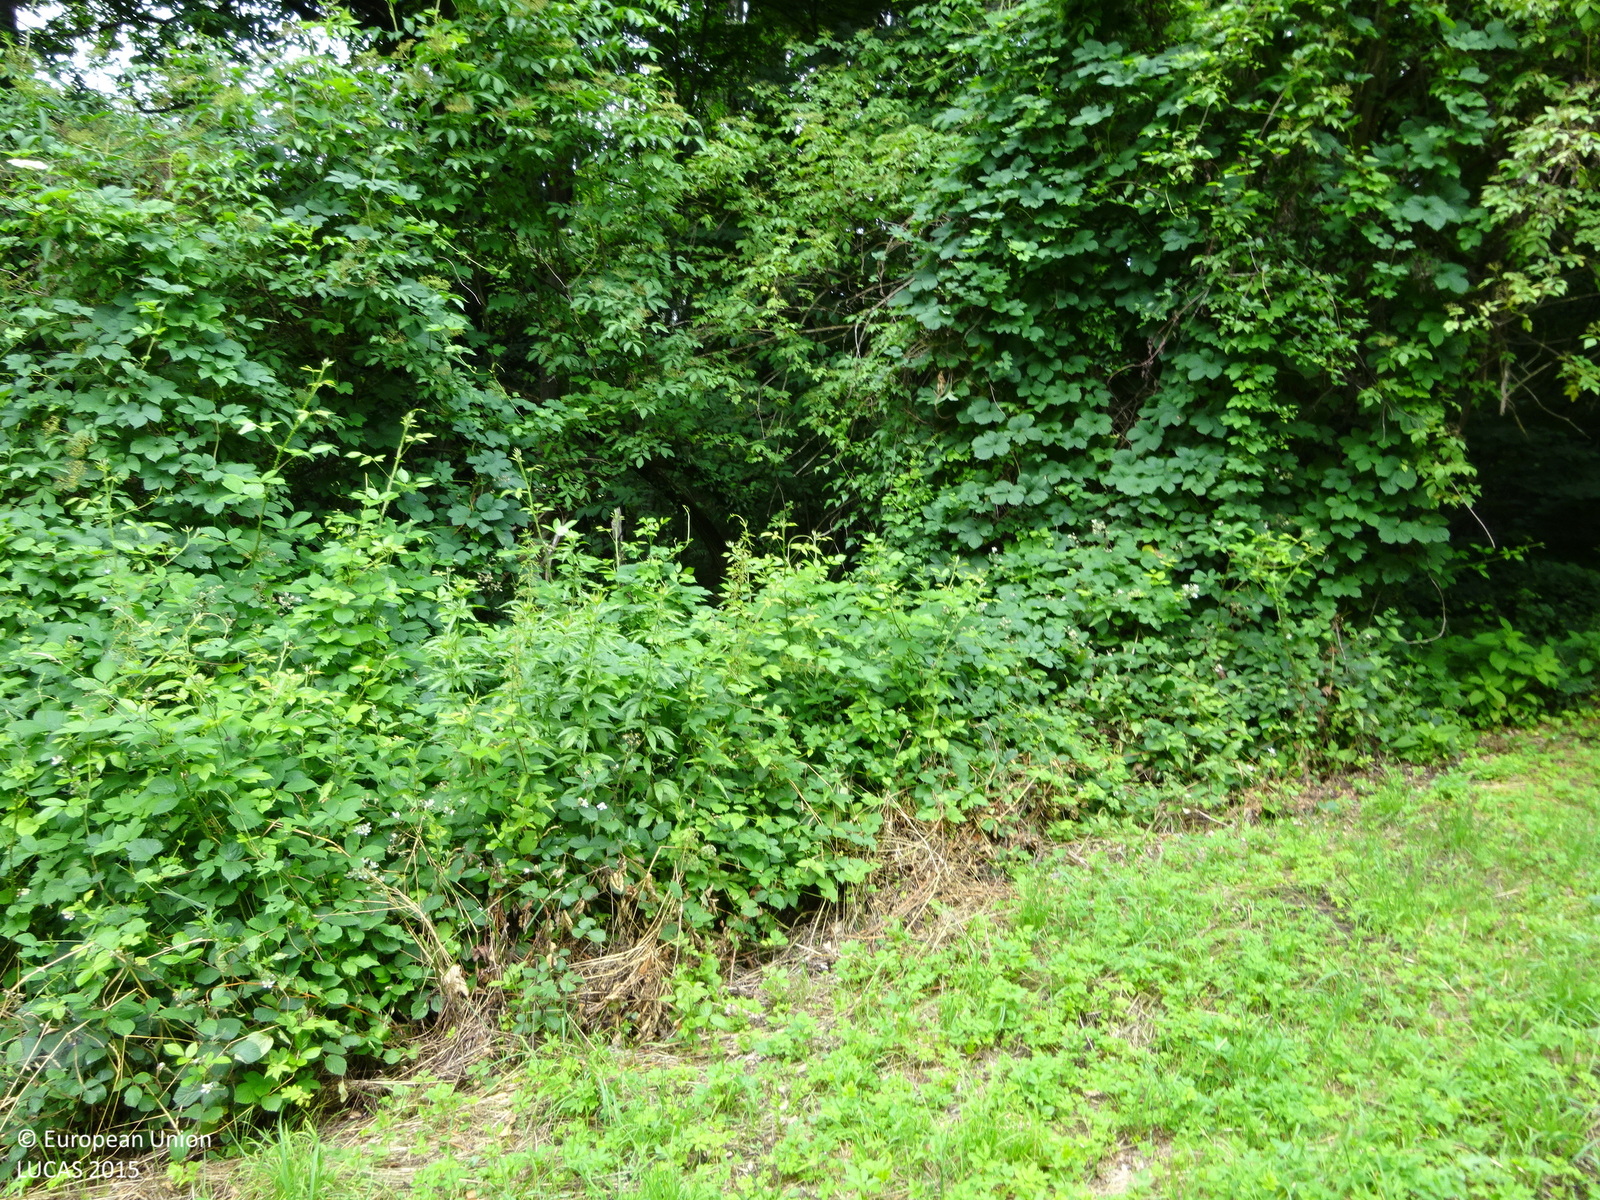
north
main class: Grassland
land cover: Grassland without tree/shrub cover
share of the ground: > 75 %
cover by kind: herbaceous plants 100 %
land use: Agriculture (excluding fallow land and kitchen gardens)
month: June
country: AT
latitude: 46.7174
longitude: 15.4545
